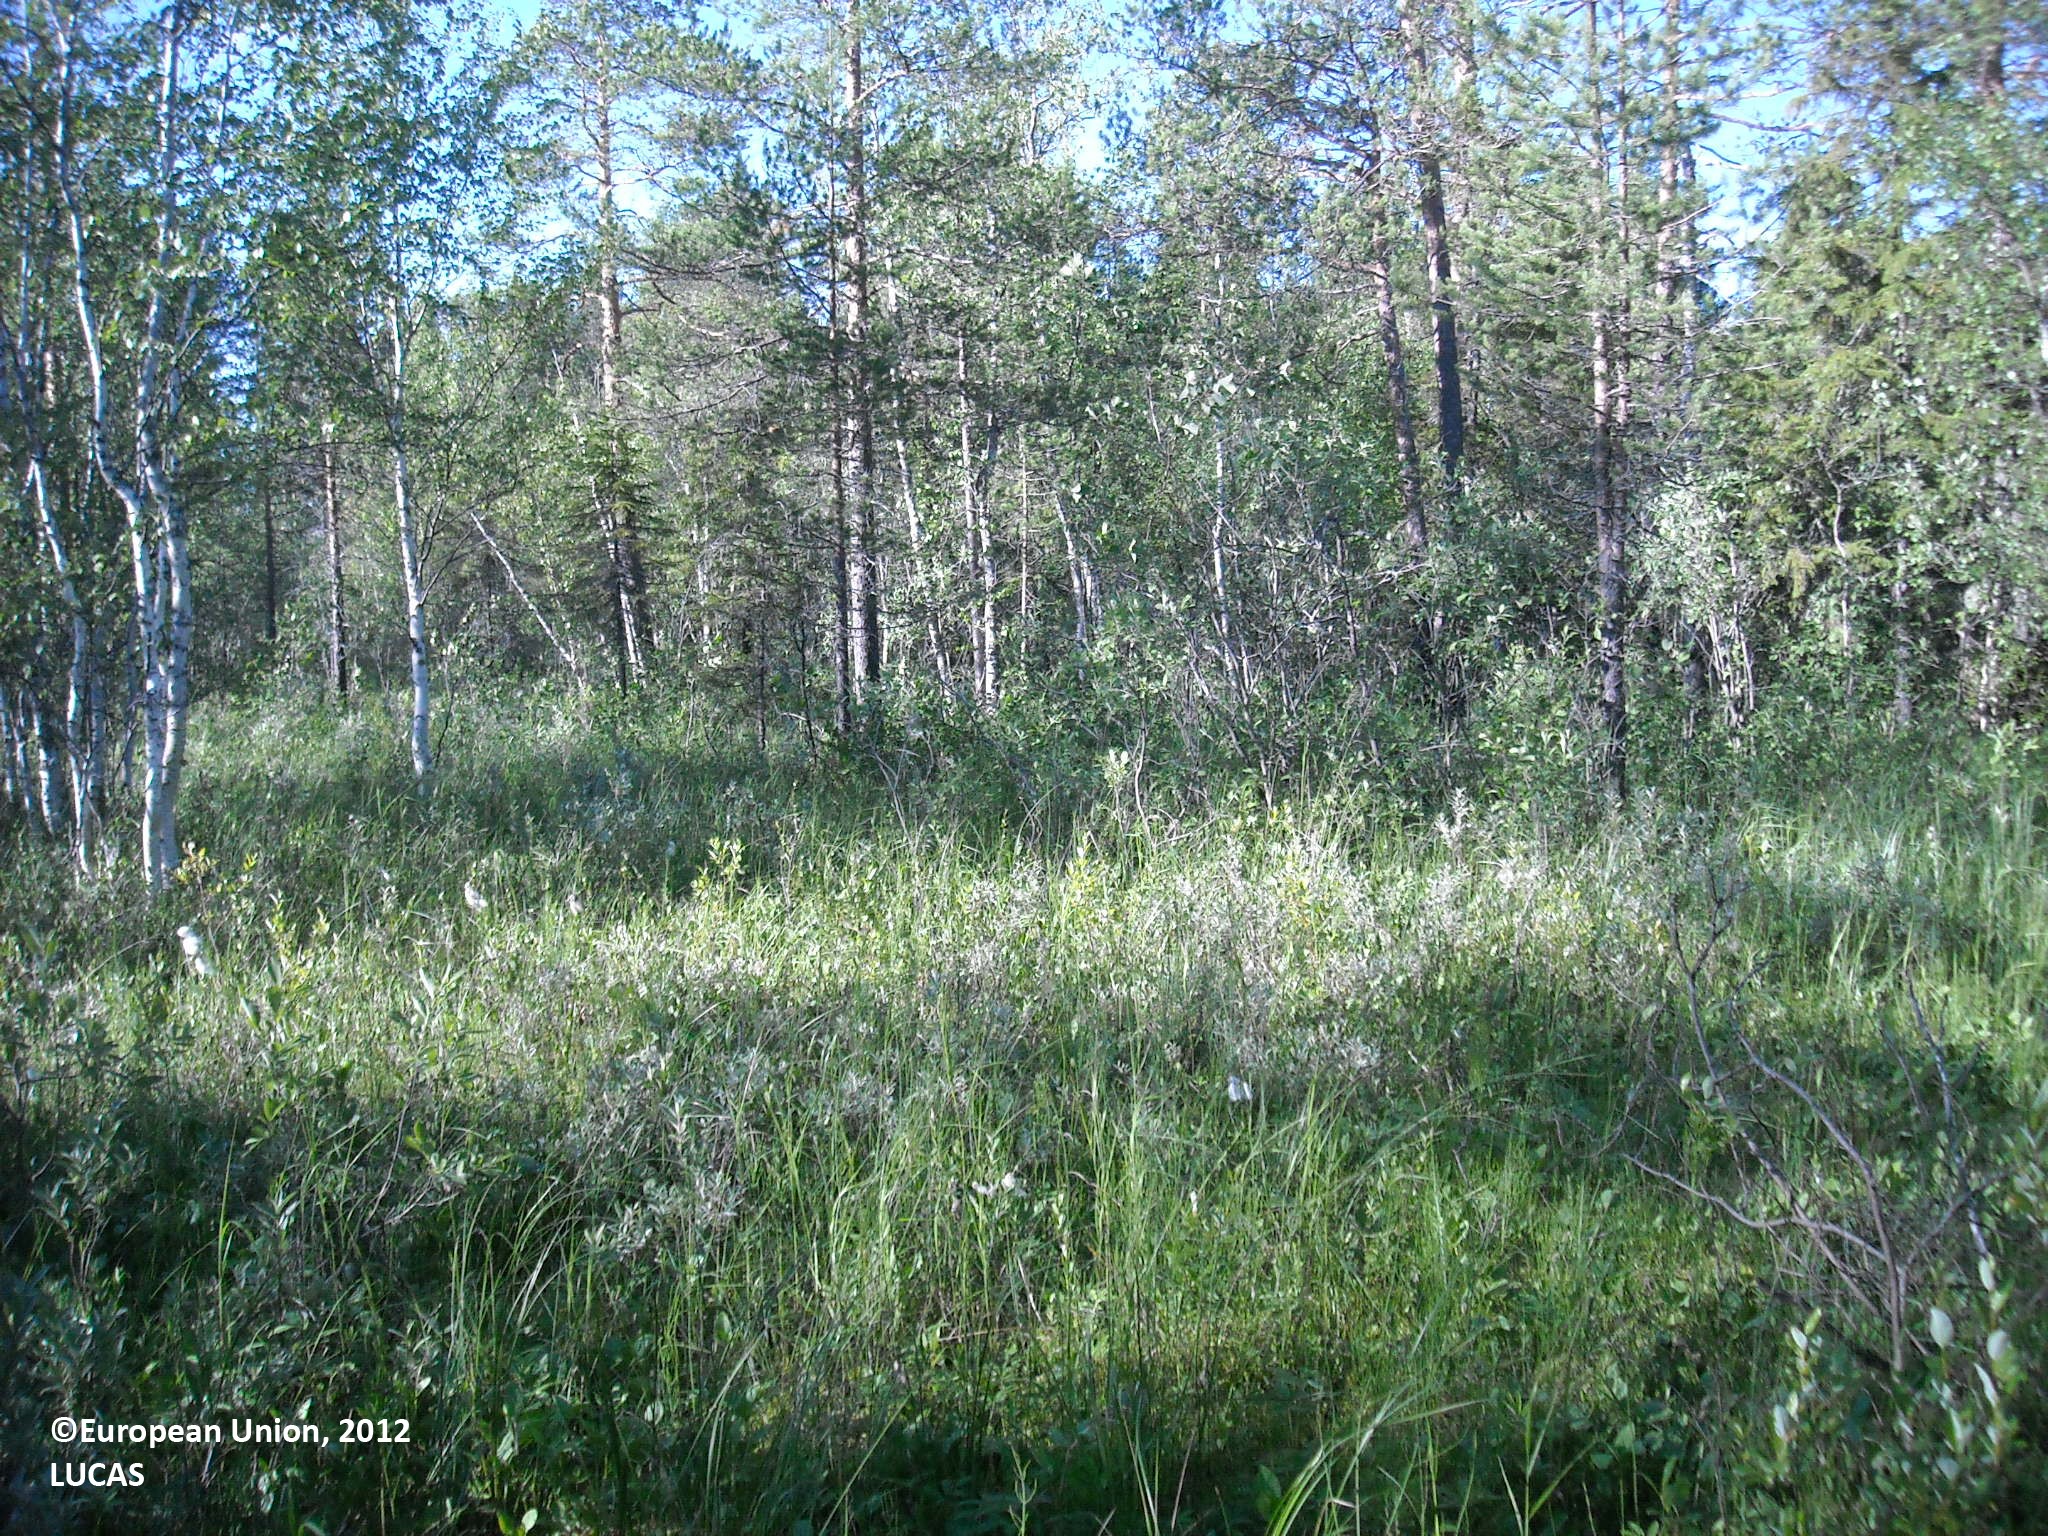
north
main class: Woodland
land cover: Broadleaved woodland
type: mire and swamp forests
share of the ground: 50 - 75 %
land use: Semi-natural and natural areas not in use
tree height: > 5 m
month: July
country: FI
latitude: 65.1603
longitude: 27.6985
